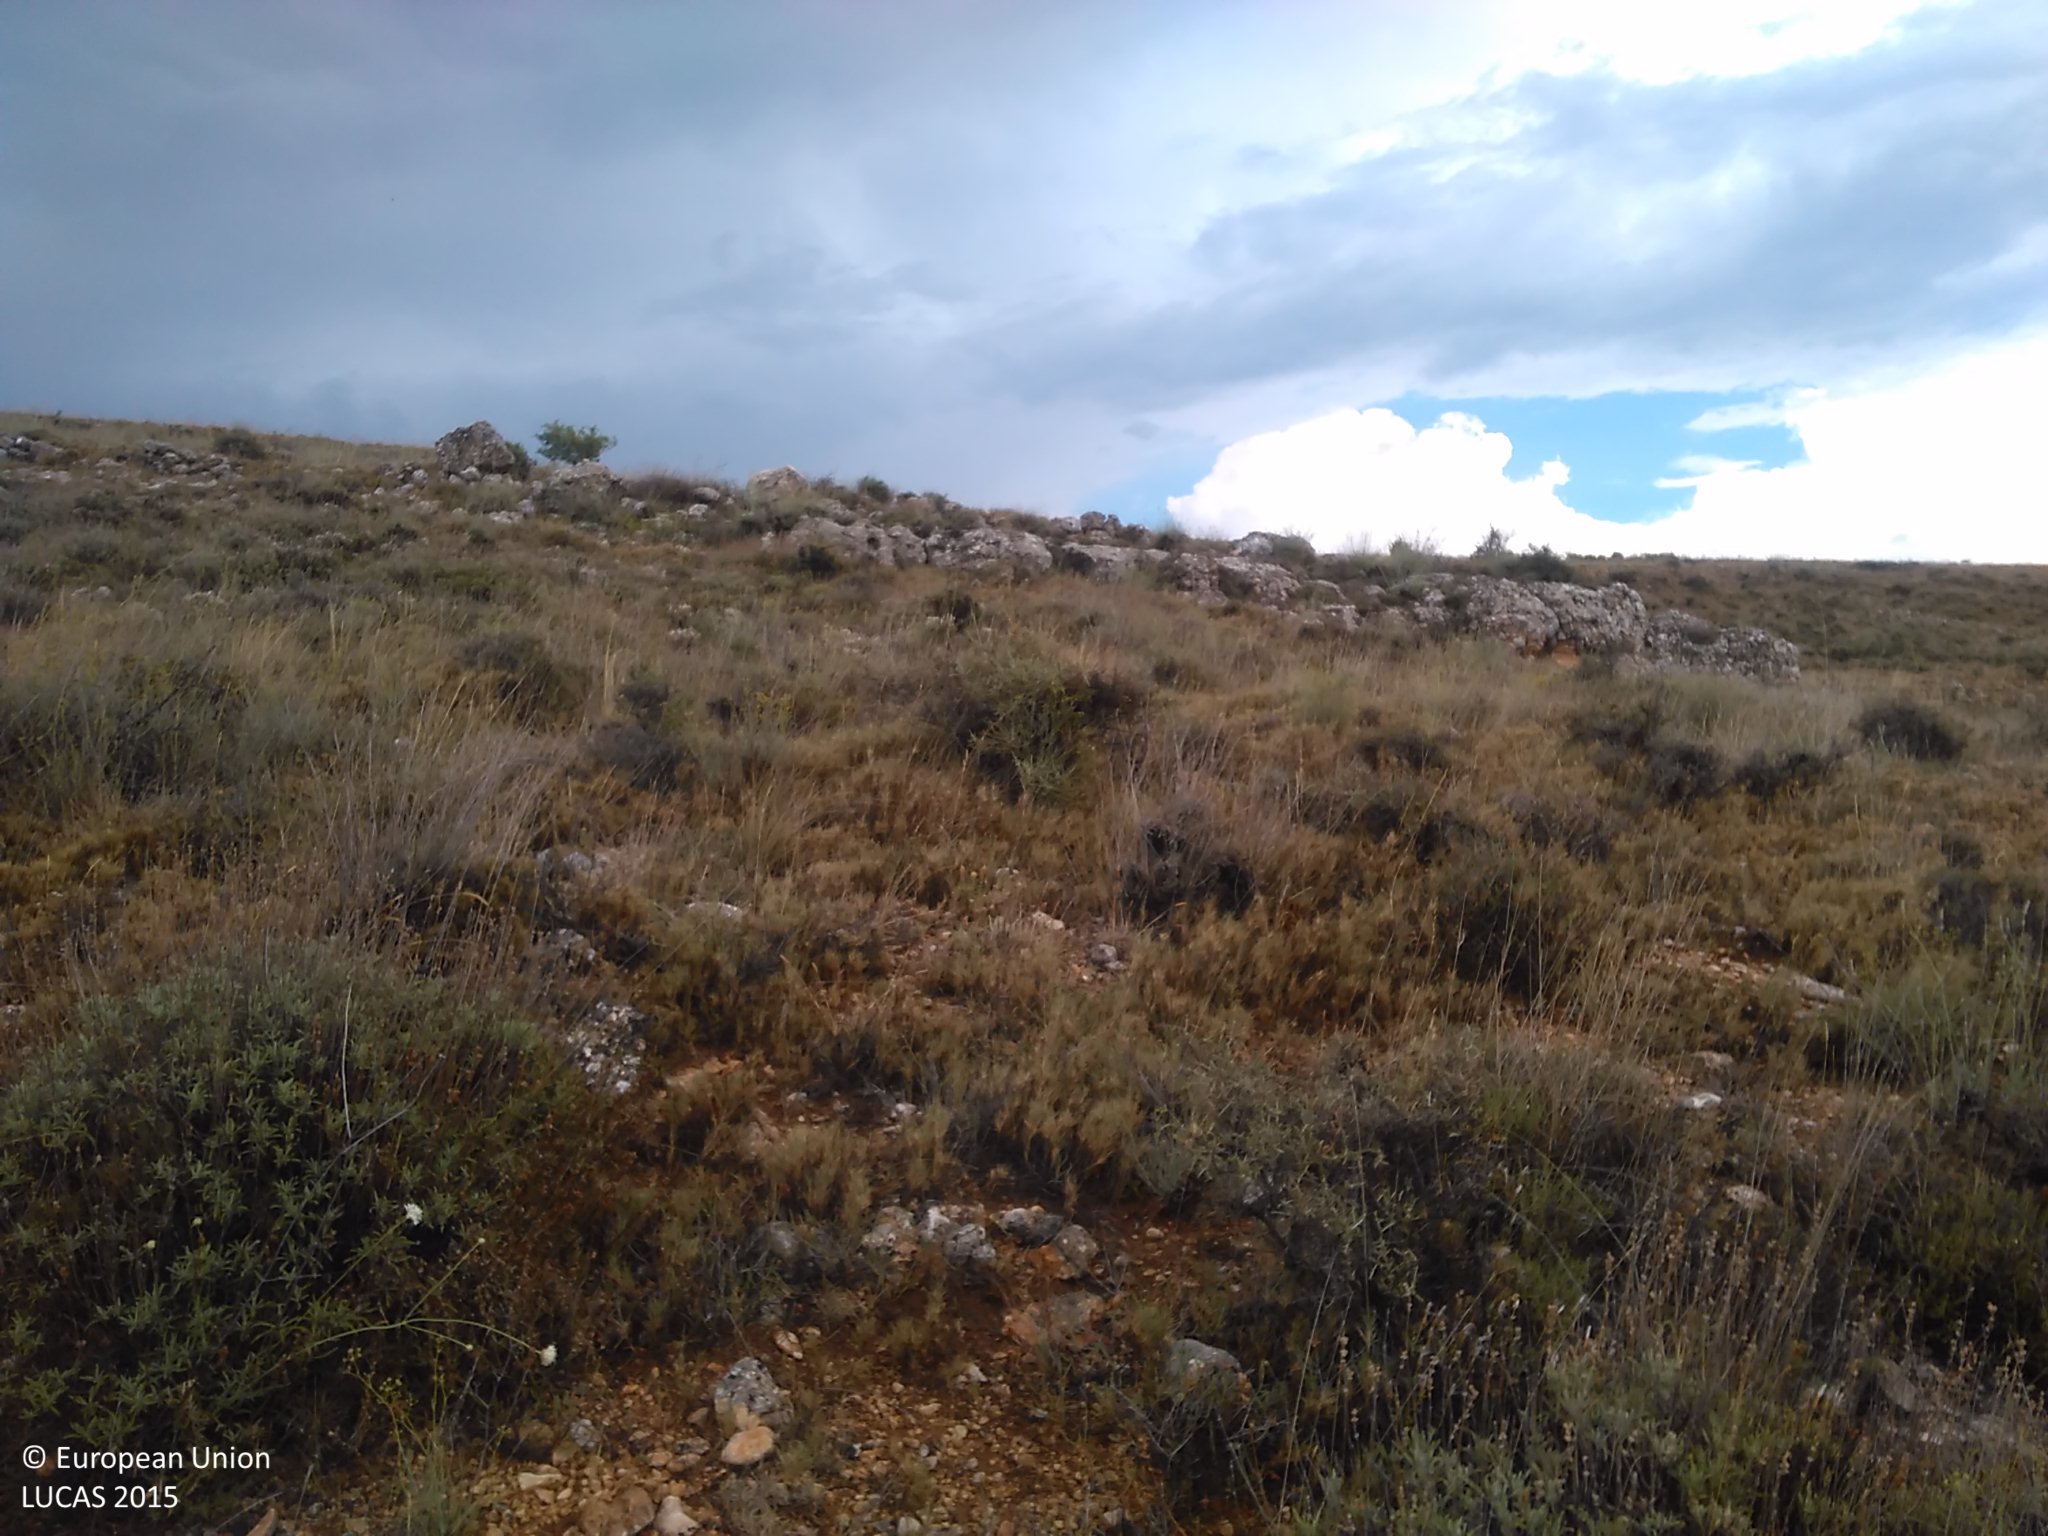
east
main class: Shrubland
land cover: Shrubland without tree cover
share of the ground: 50 - 75 %
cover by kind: shrubs 60 %, herbaceous plants 20 %, unconsolidated bare surface 20 %
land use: Semi-natural and natural areas not in use
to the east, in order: Shrubland without tree cover
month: July
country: ES
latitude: 41.4440
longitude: -2.0109
